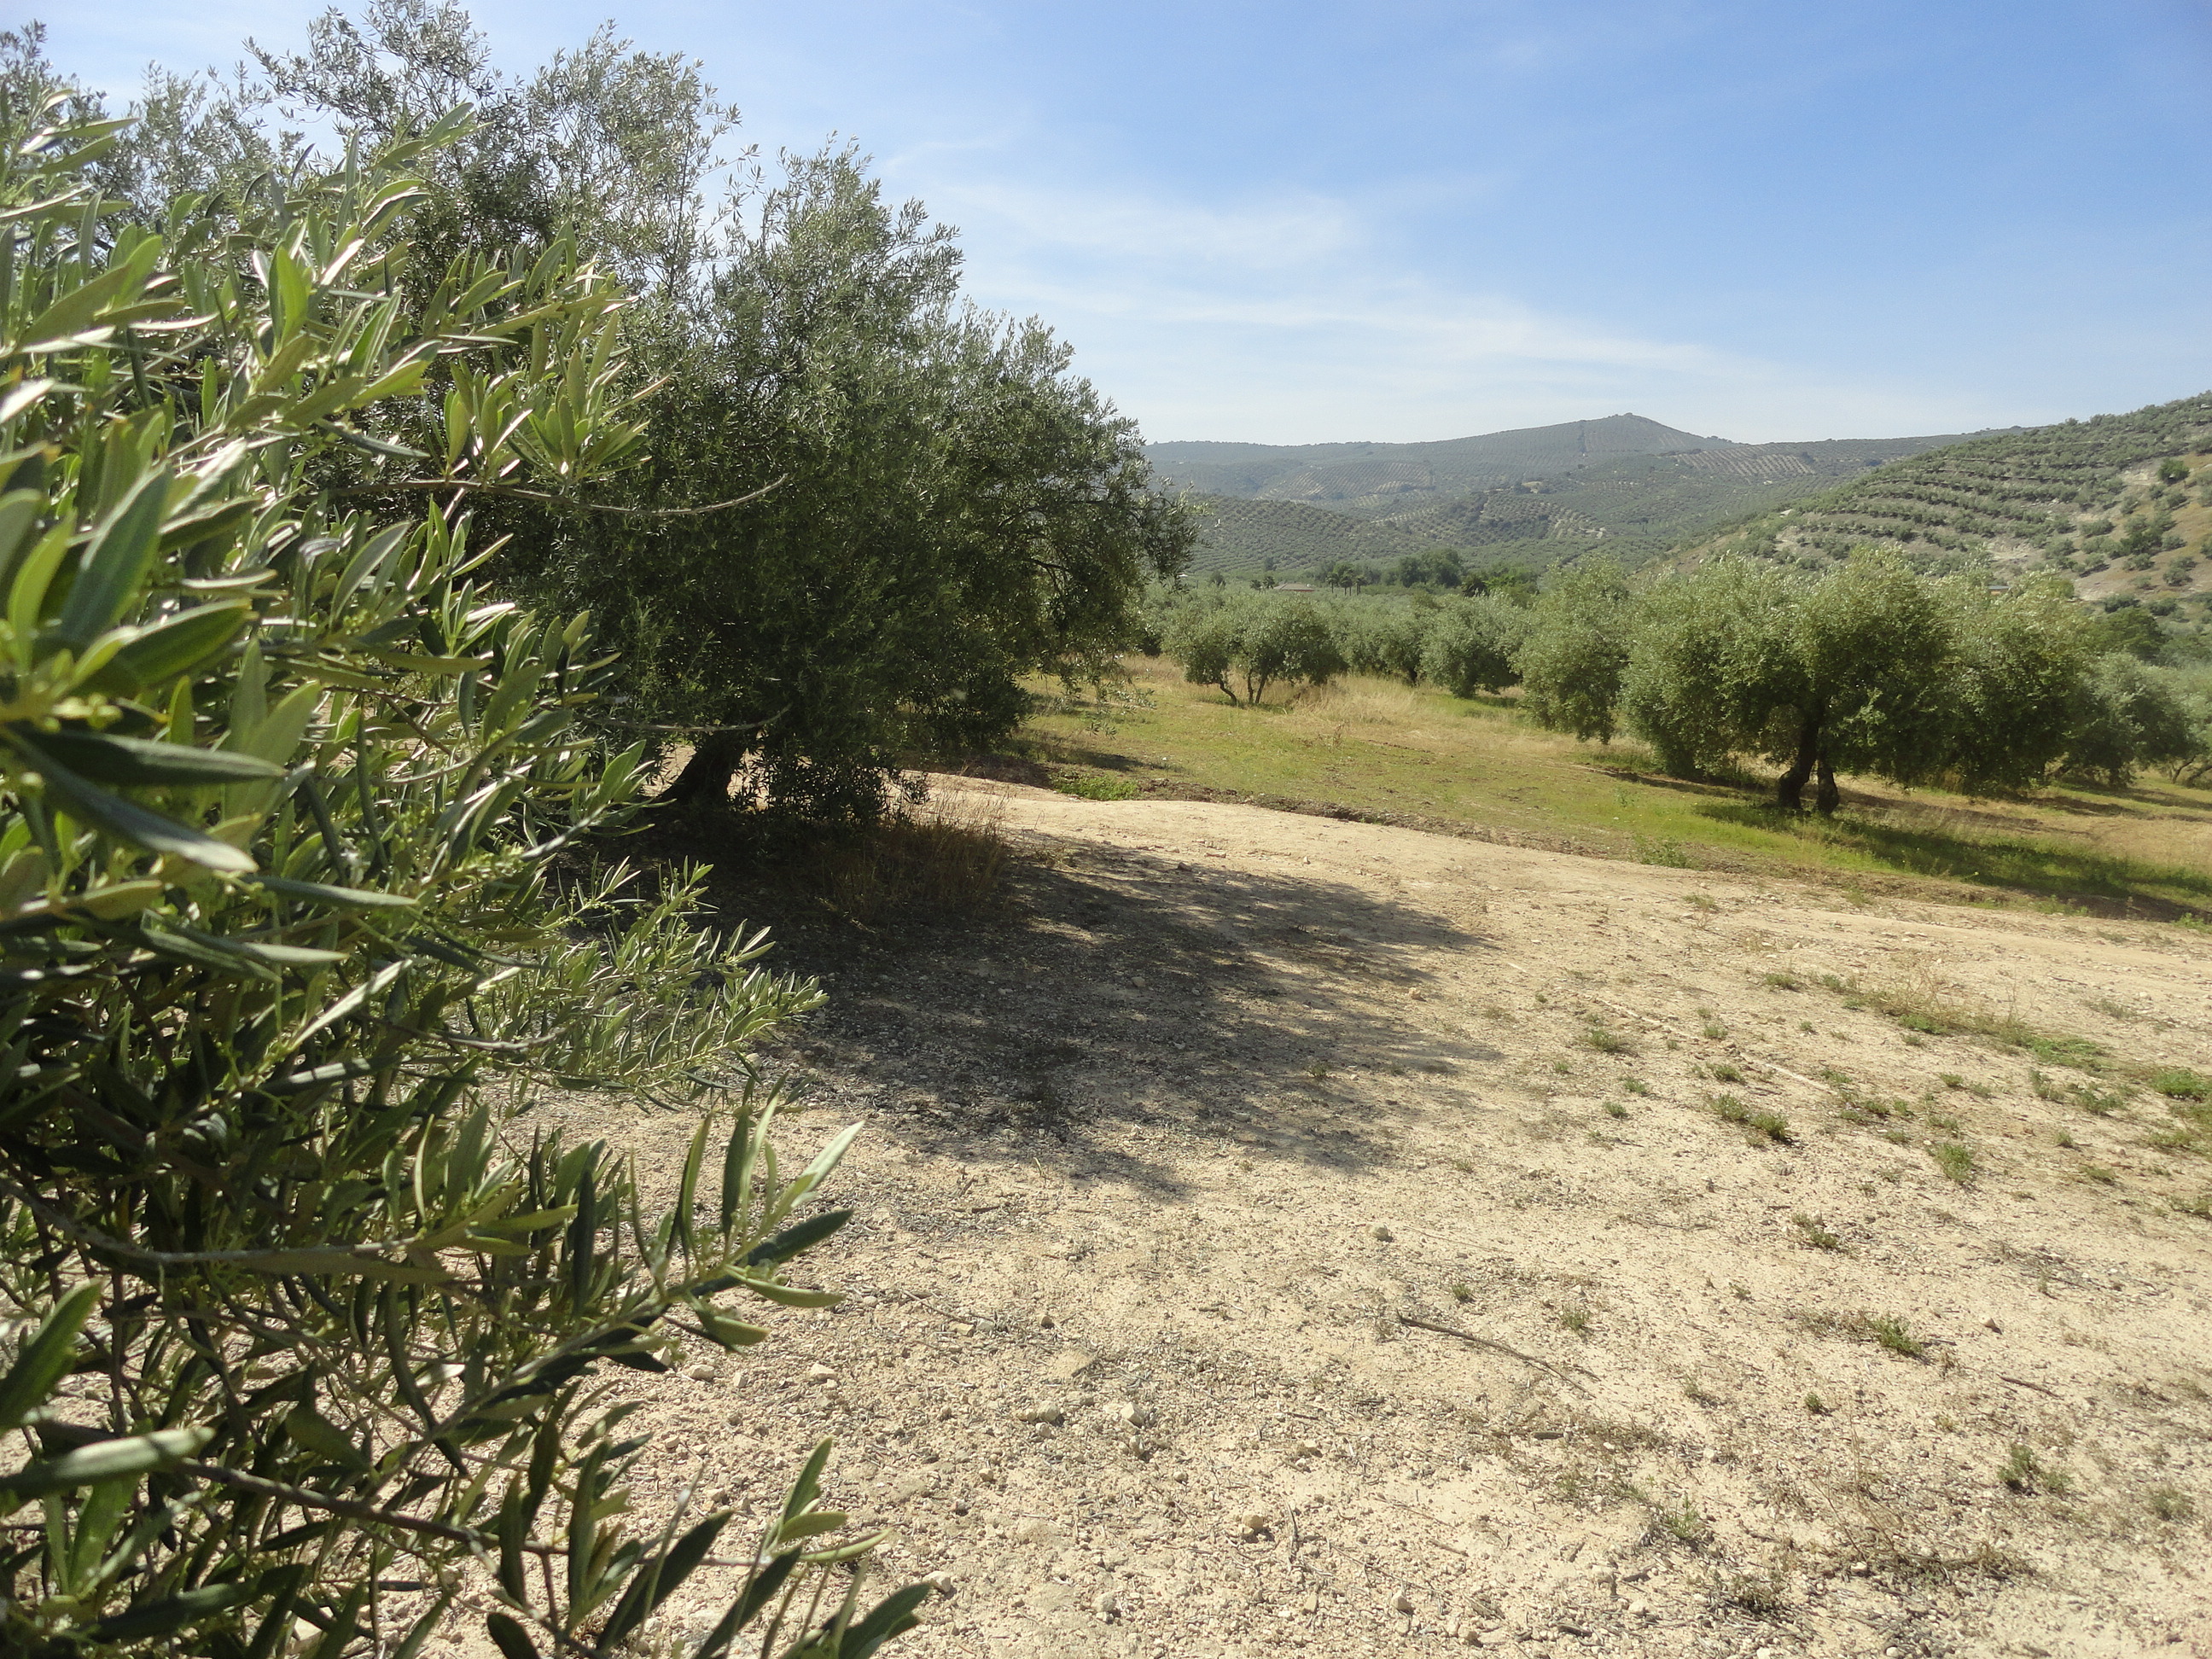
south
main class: Cropland
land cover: Olive groves
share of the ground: 25 - 50 %
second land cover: Spontaneously vegetated surfaces
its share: 10 - 25 %
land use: Agriculture (excluding fallow land and kitchen gardens)
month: April
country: ES
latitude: 37.6053
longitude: -4.4938
